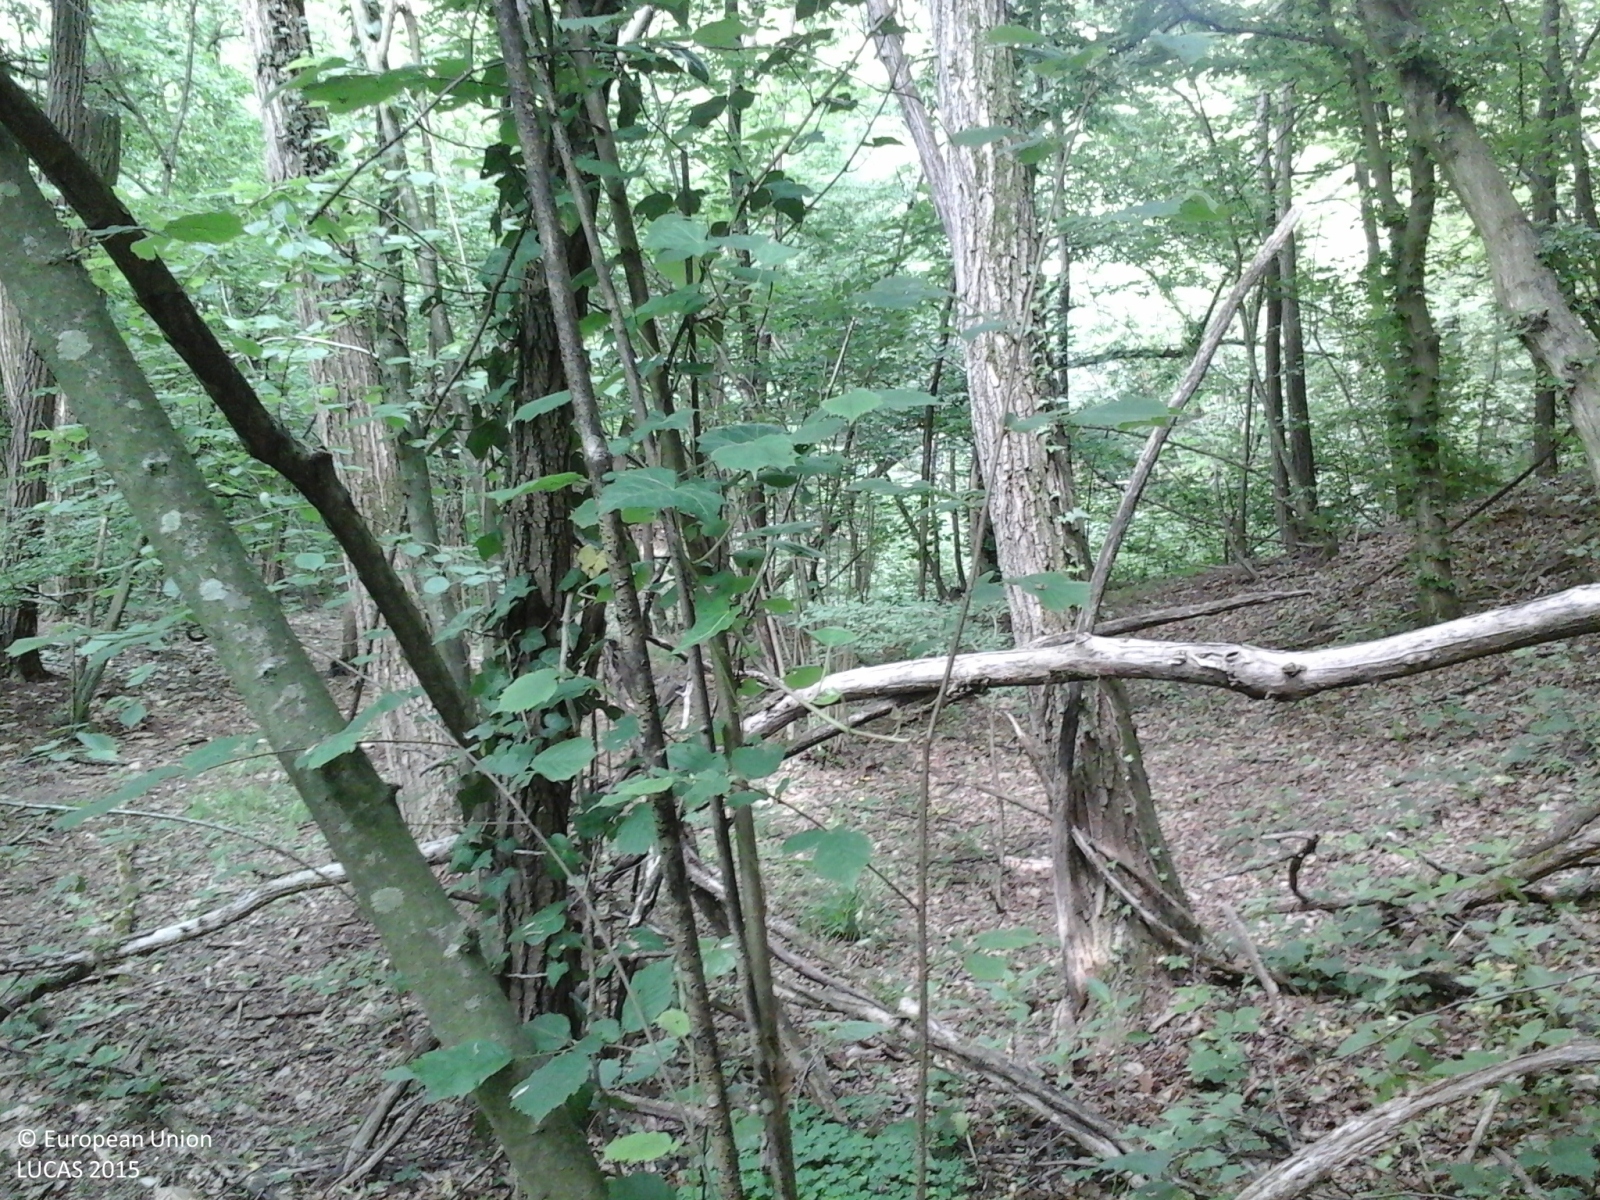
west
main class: Woodland
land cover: Broadleaved woodland
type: mesophytic deciduous forest
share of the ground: > 75 %
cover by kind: broadleaved forest trees 100 %
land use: Forestry
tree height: > 5 m
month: May
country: IT
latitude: 45.5615
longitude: 8.2220
